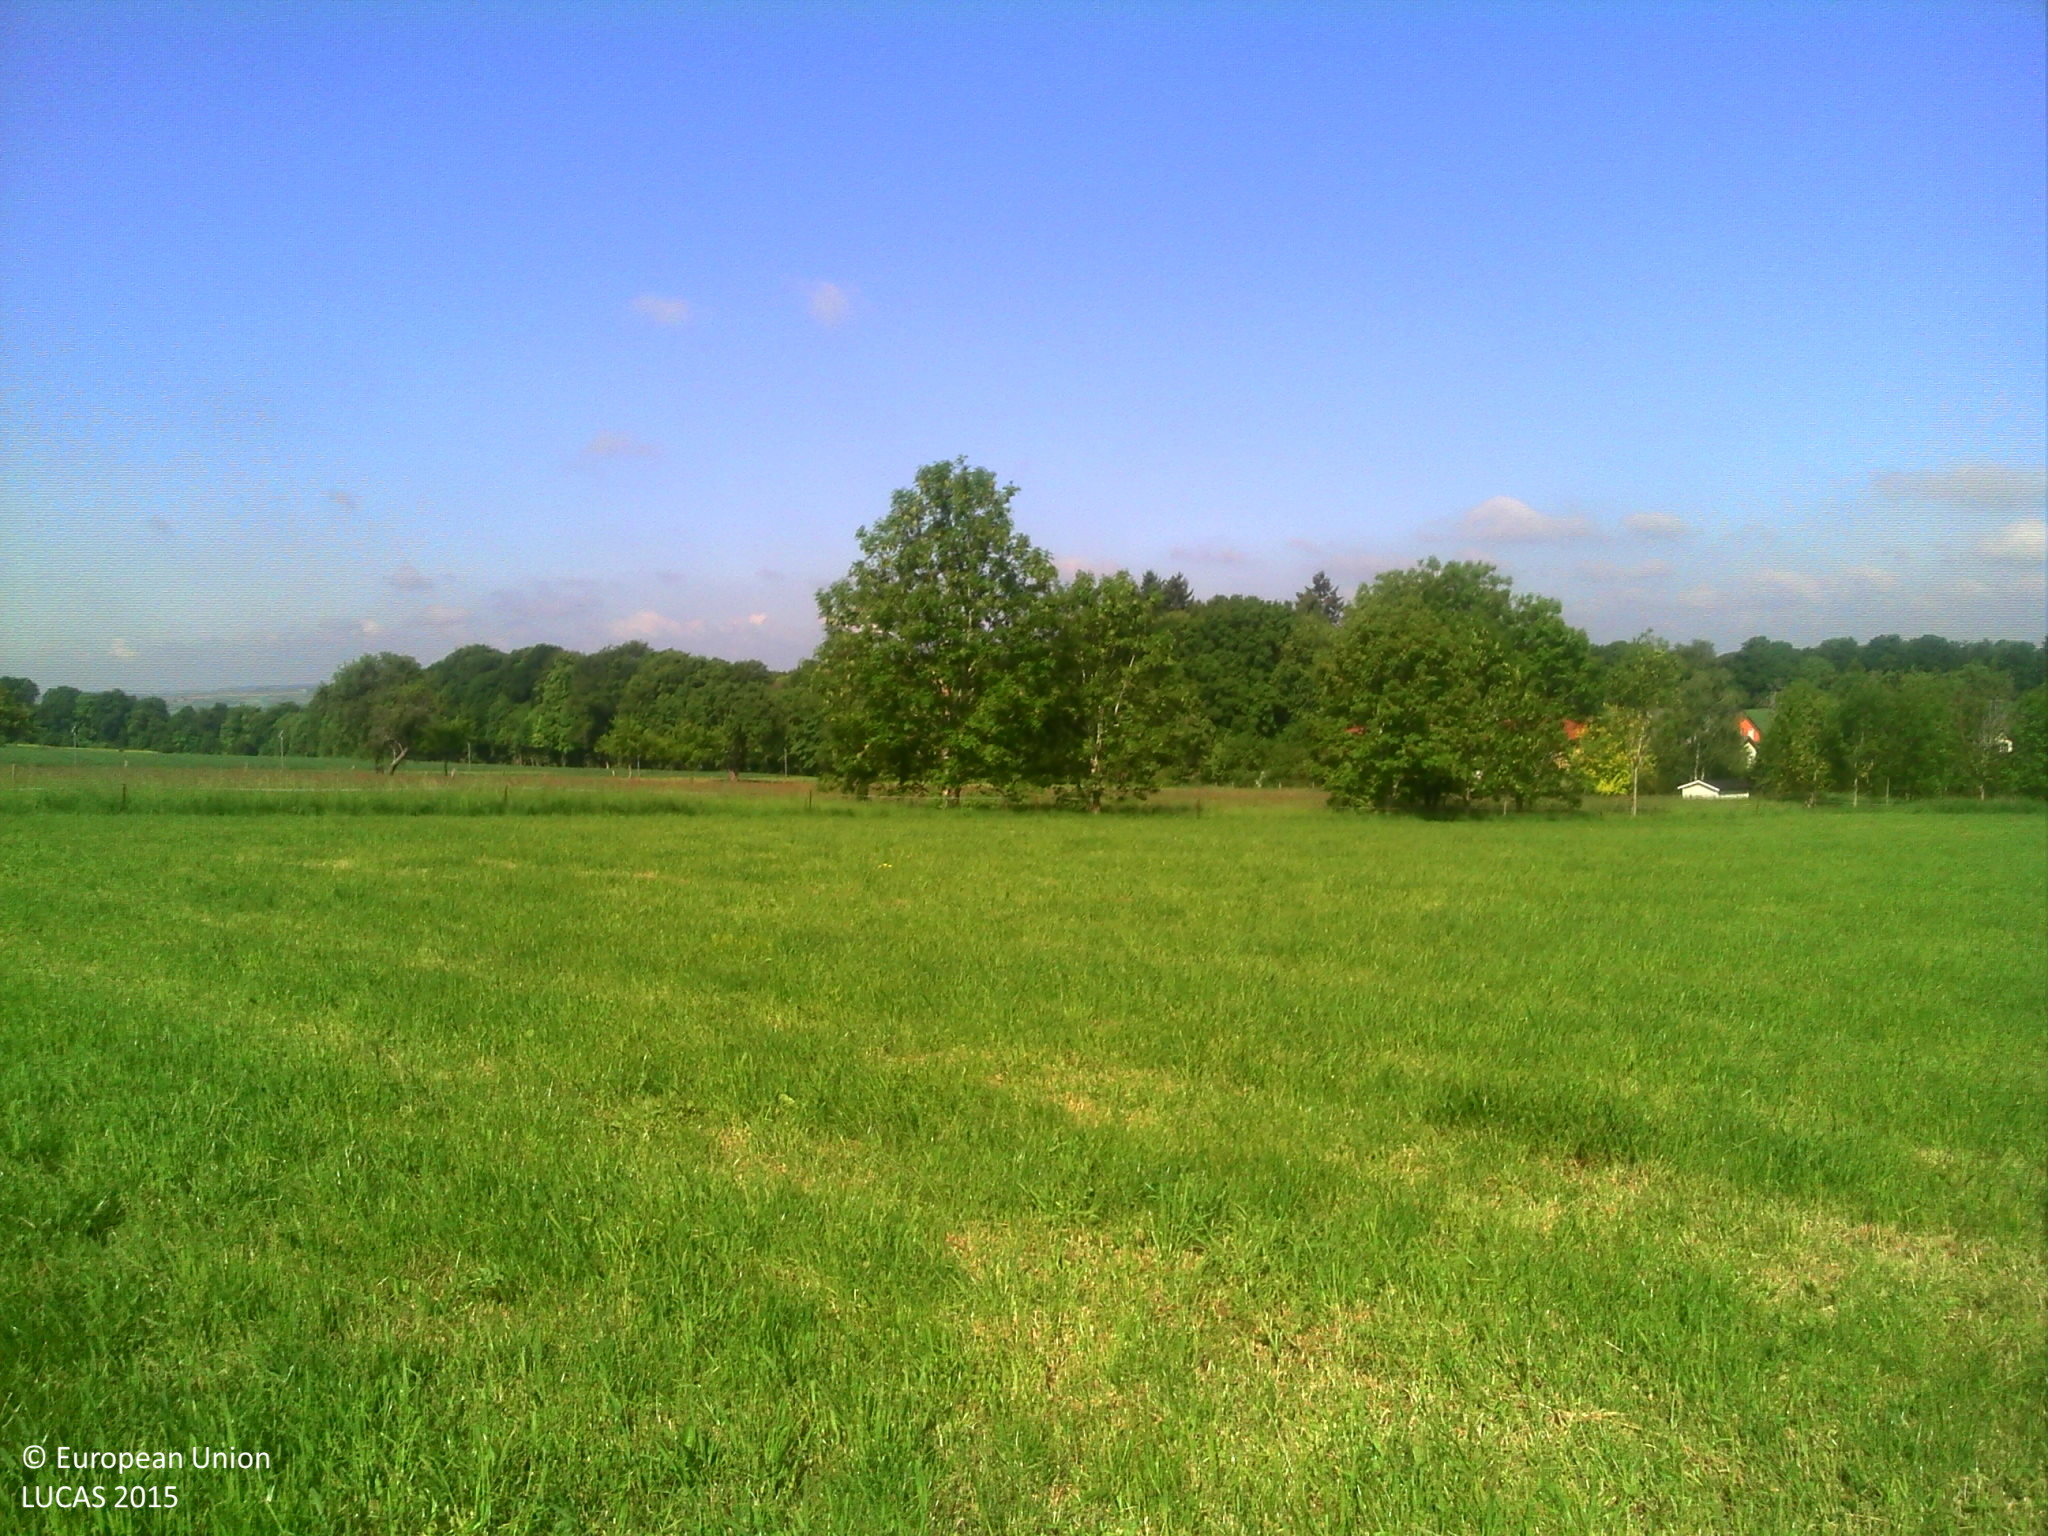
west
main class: Grassland
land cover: Grassland without tree/shrub cover
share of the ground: > 75 %
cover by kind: herbaceous plants 100 %
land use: Agriculture (excluding fallow land and kitchen gardens)
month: May
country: LU
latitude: 49.8196
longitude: 6.3441
